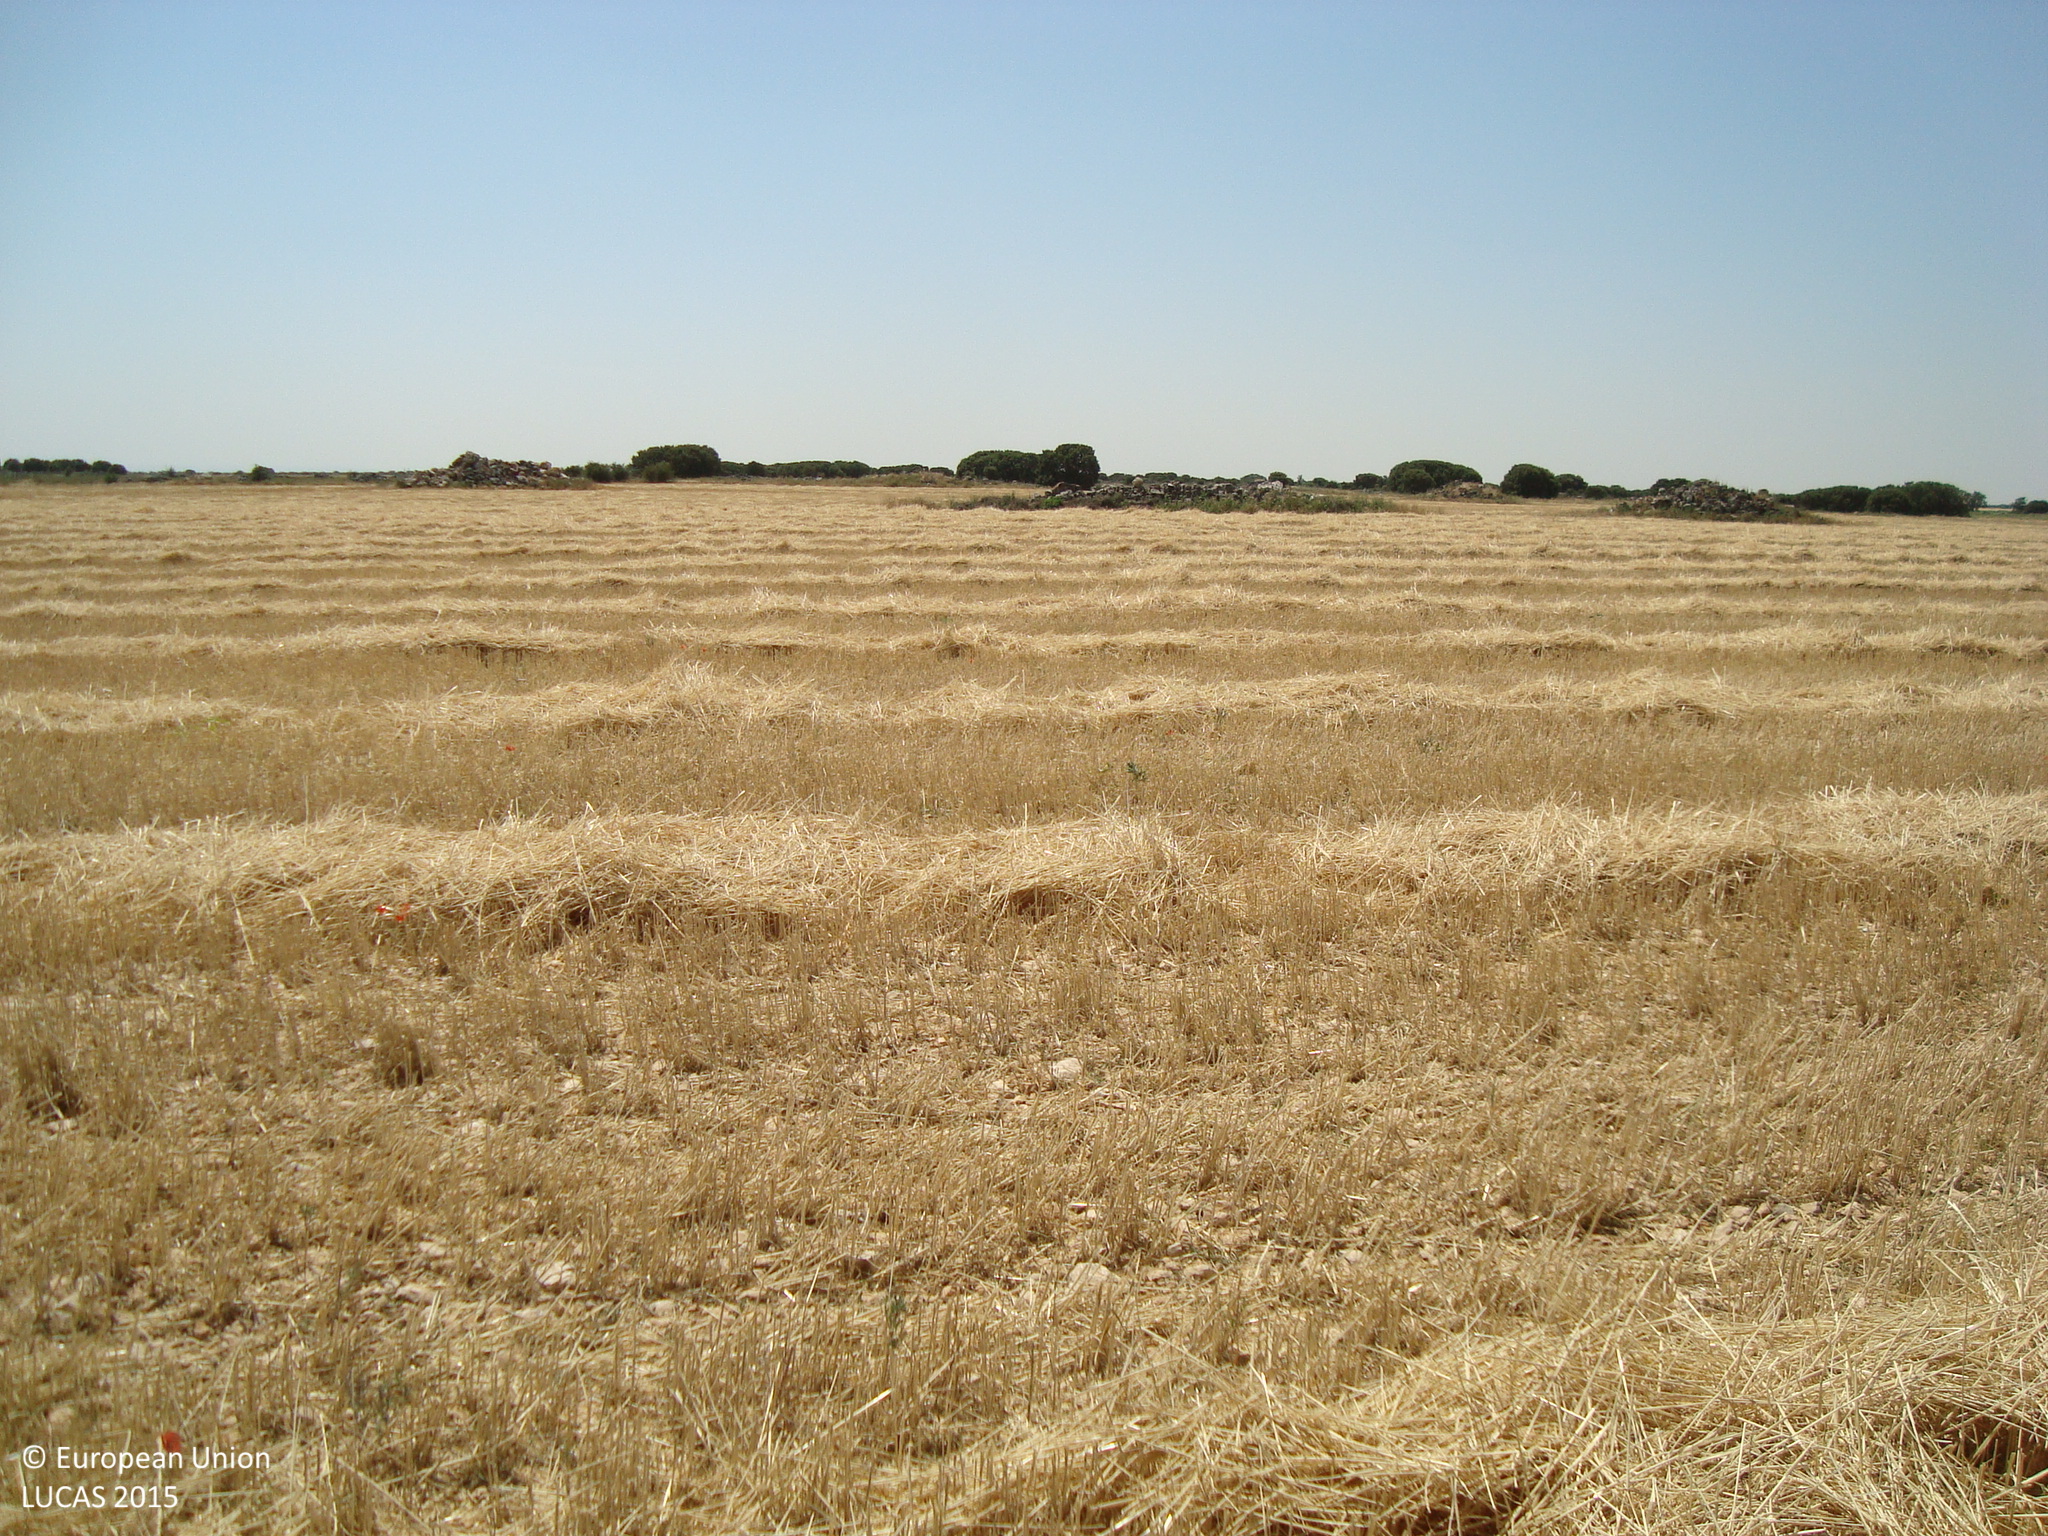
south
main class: Cropland
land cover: Common wheat
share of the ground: > 75 %
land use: Agriculture (excluding fallow land and kitchen gardens)
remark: Harvested field
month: July
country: ES
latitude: 41.8252
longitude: -4.1116
